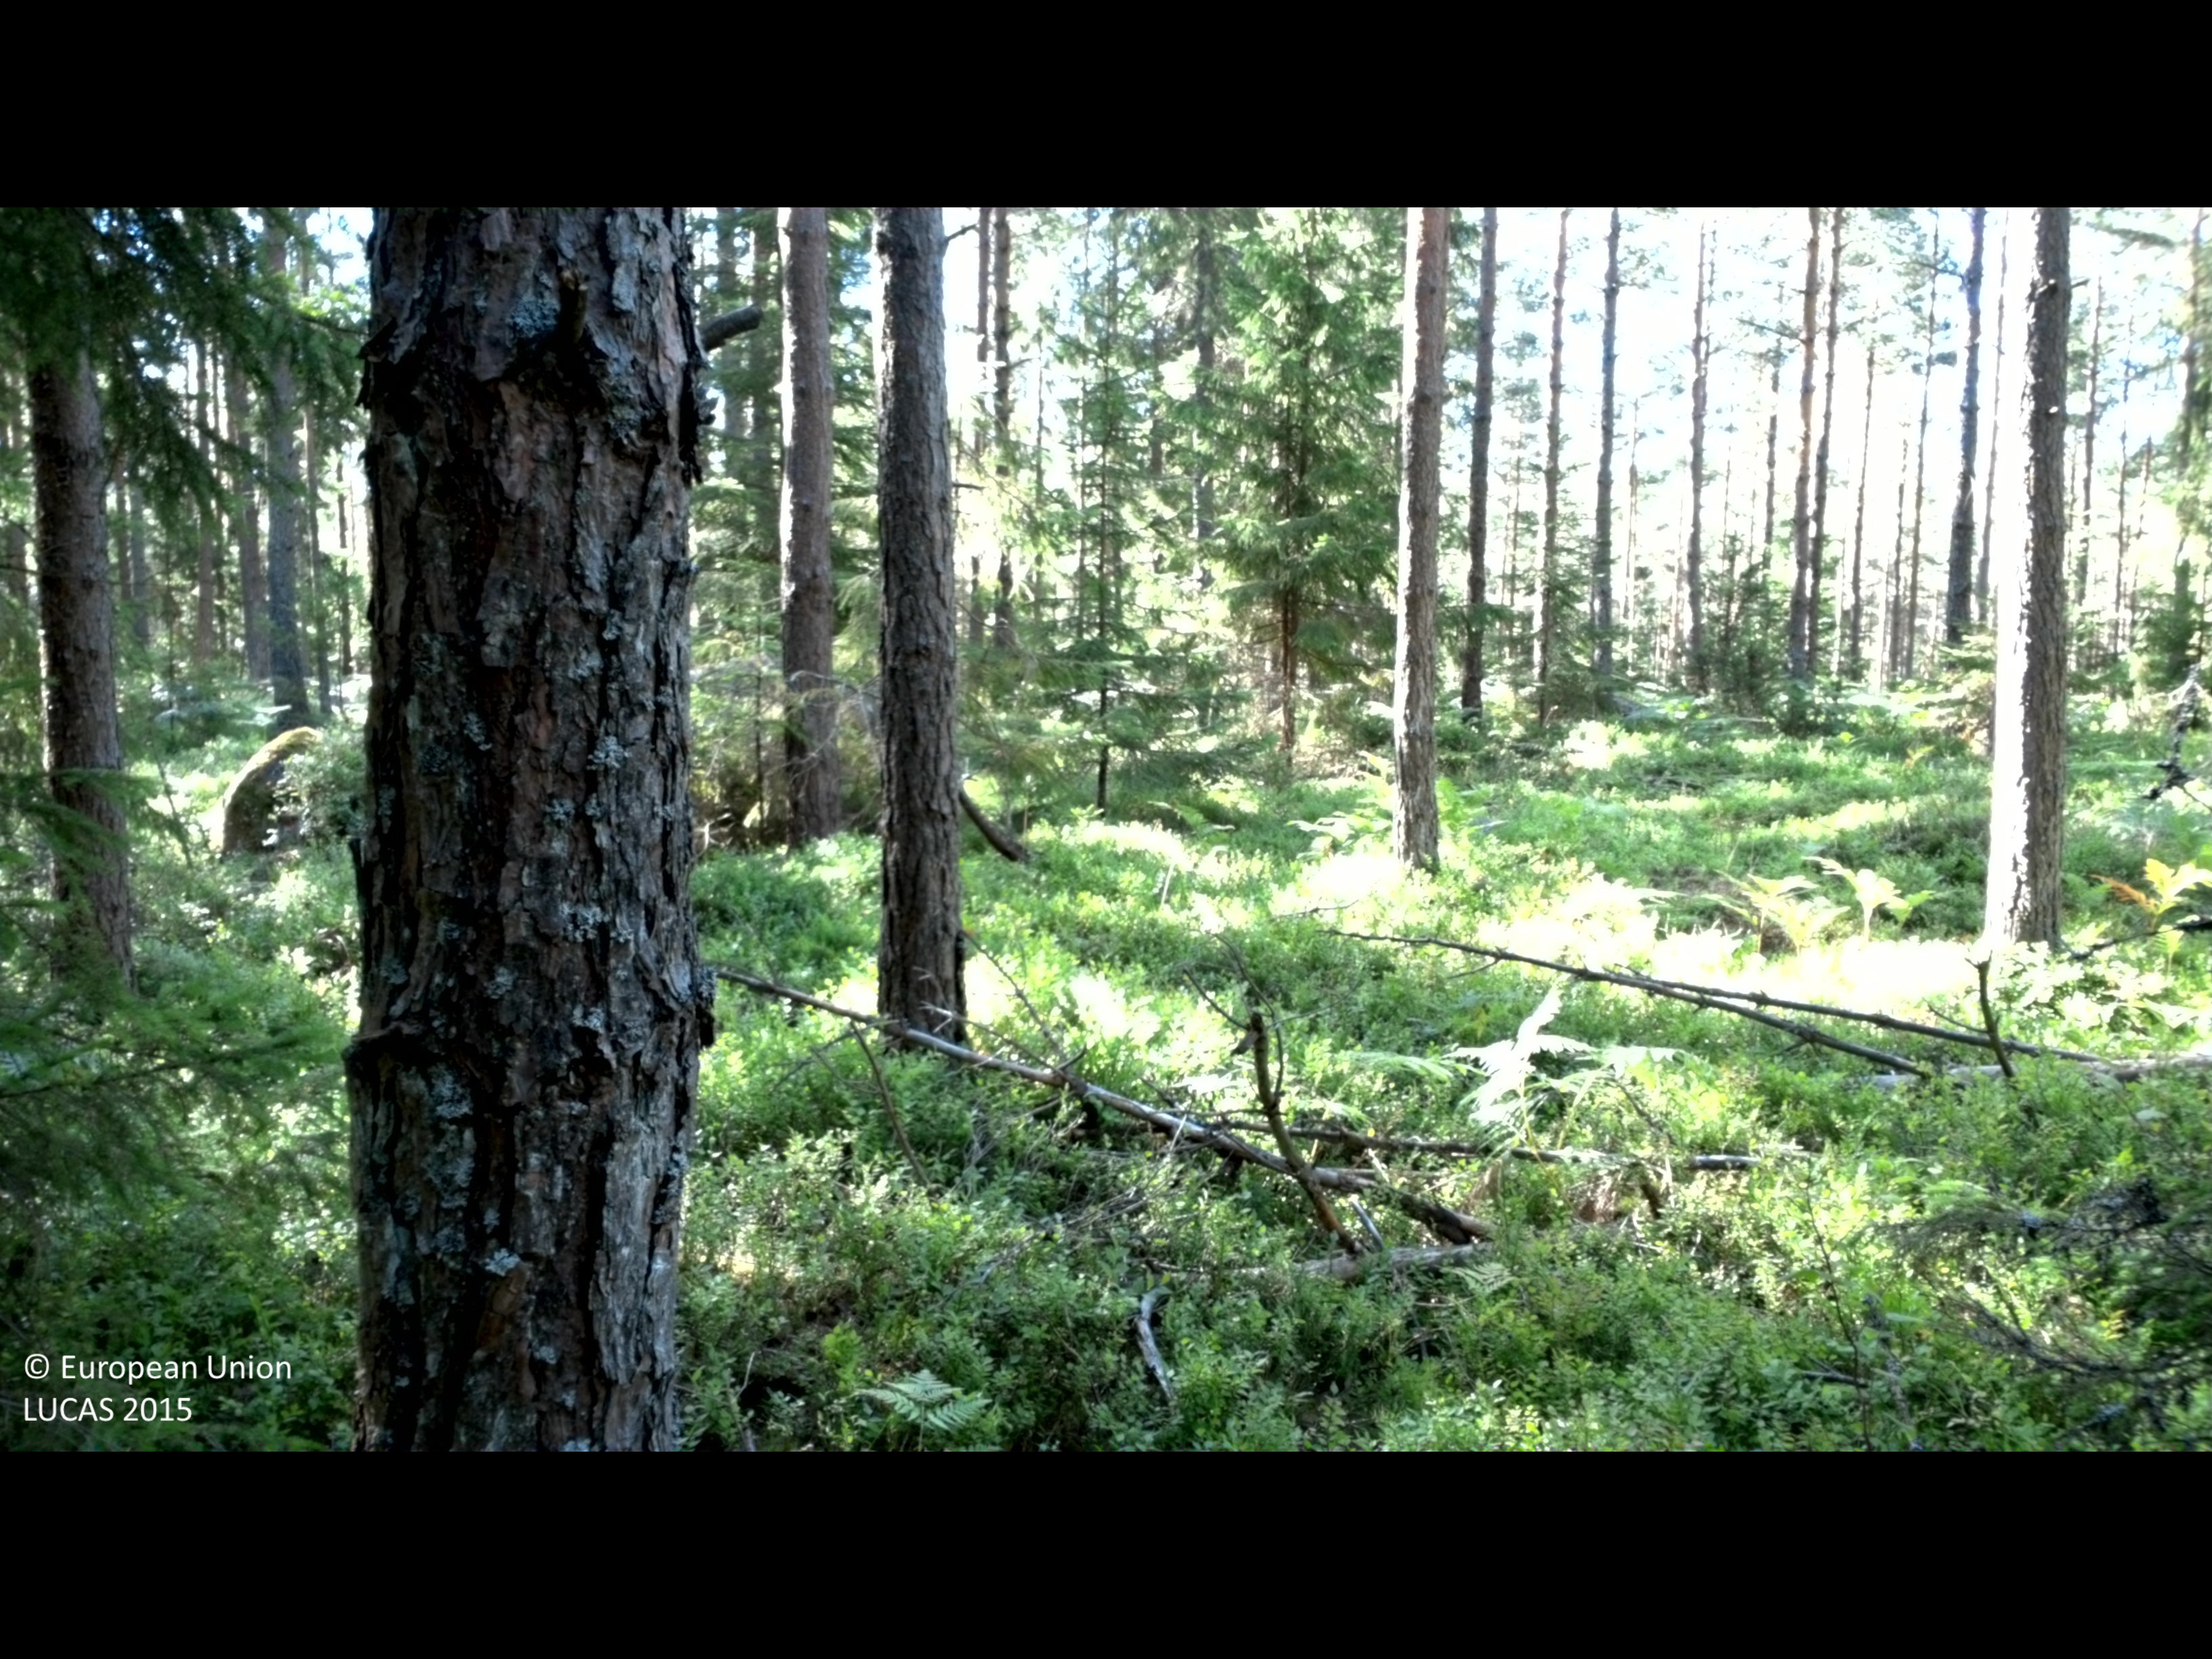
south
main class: Woodland
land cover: Pine dominated coniferous woodland
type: boreal forest
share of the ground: 50 - 75 %
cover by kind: coniferous forest trees 55 %, shrubs 45 %
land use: Forestry
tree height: > 5 m
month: August
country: SE
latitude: 56.3501
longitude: 14.8040
